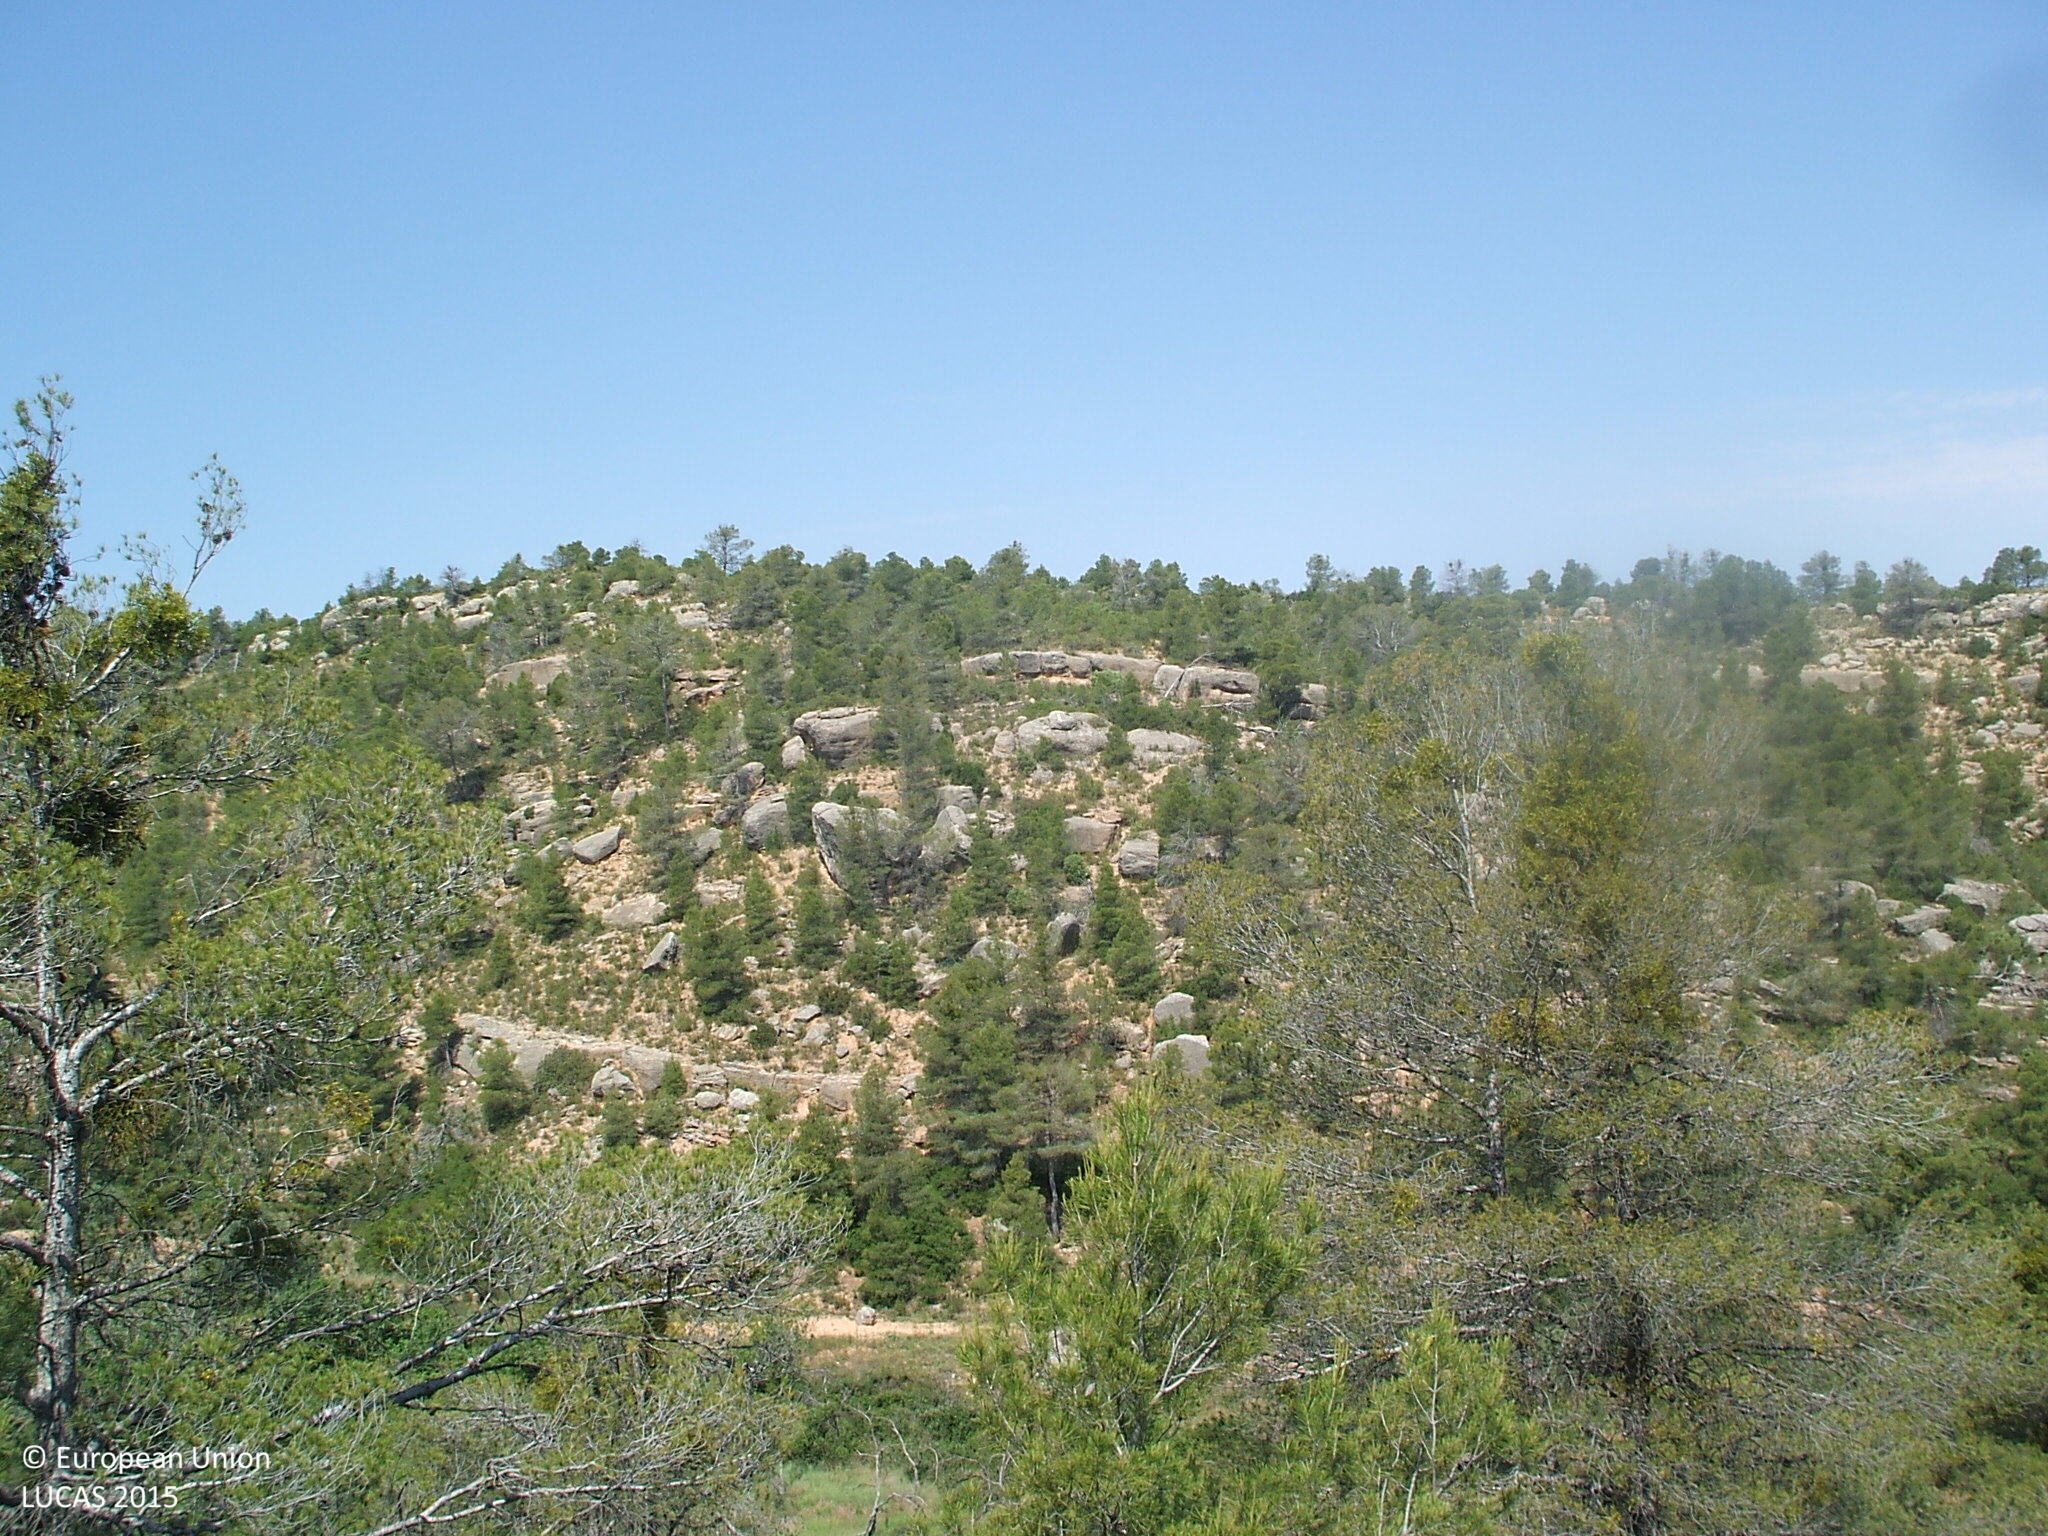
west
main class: Woodland
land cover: Pine dominated coniferous woodland
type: coniferous forest of the mediterranean region
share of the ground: 50 - 75 %
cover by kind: coniferous forest trees 70 %, shrubs 30 %
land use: Semi-natural and natural areas not in use
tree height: > 5 m
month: June
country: ES
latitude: 40.9223
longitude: -0.1631
